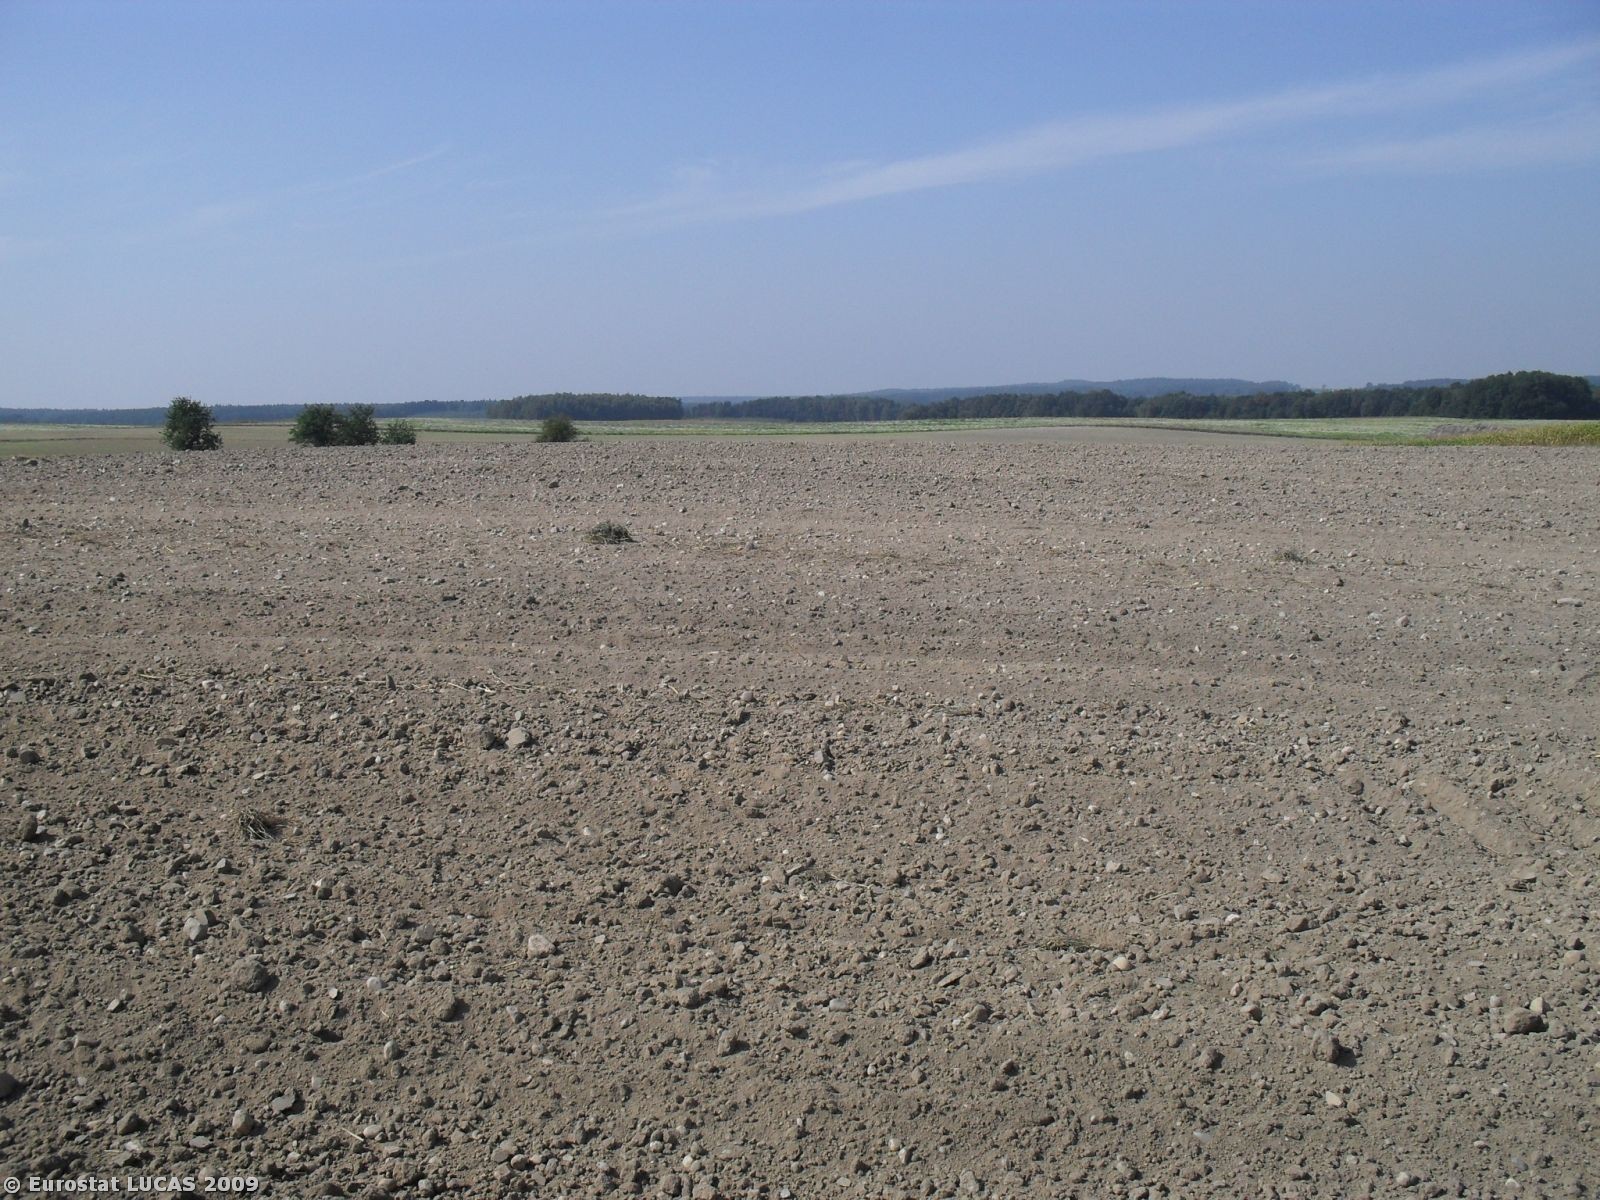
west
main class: Cropland
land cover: Barley
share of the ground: < 10 %
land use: Agriculture (excluding fallow land and kitchen gardens)
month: September
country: PL
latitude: 50.5991
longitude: 17.3158
